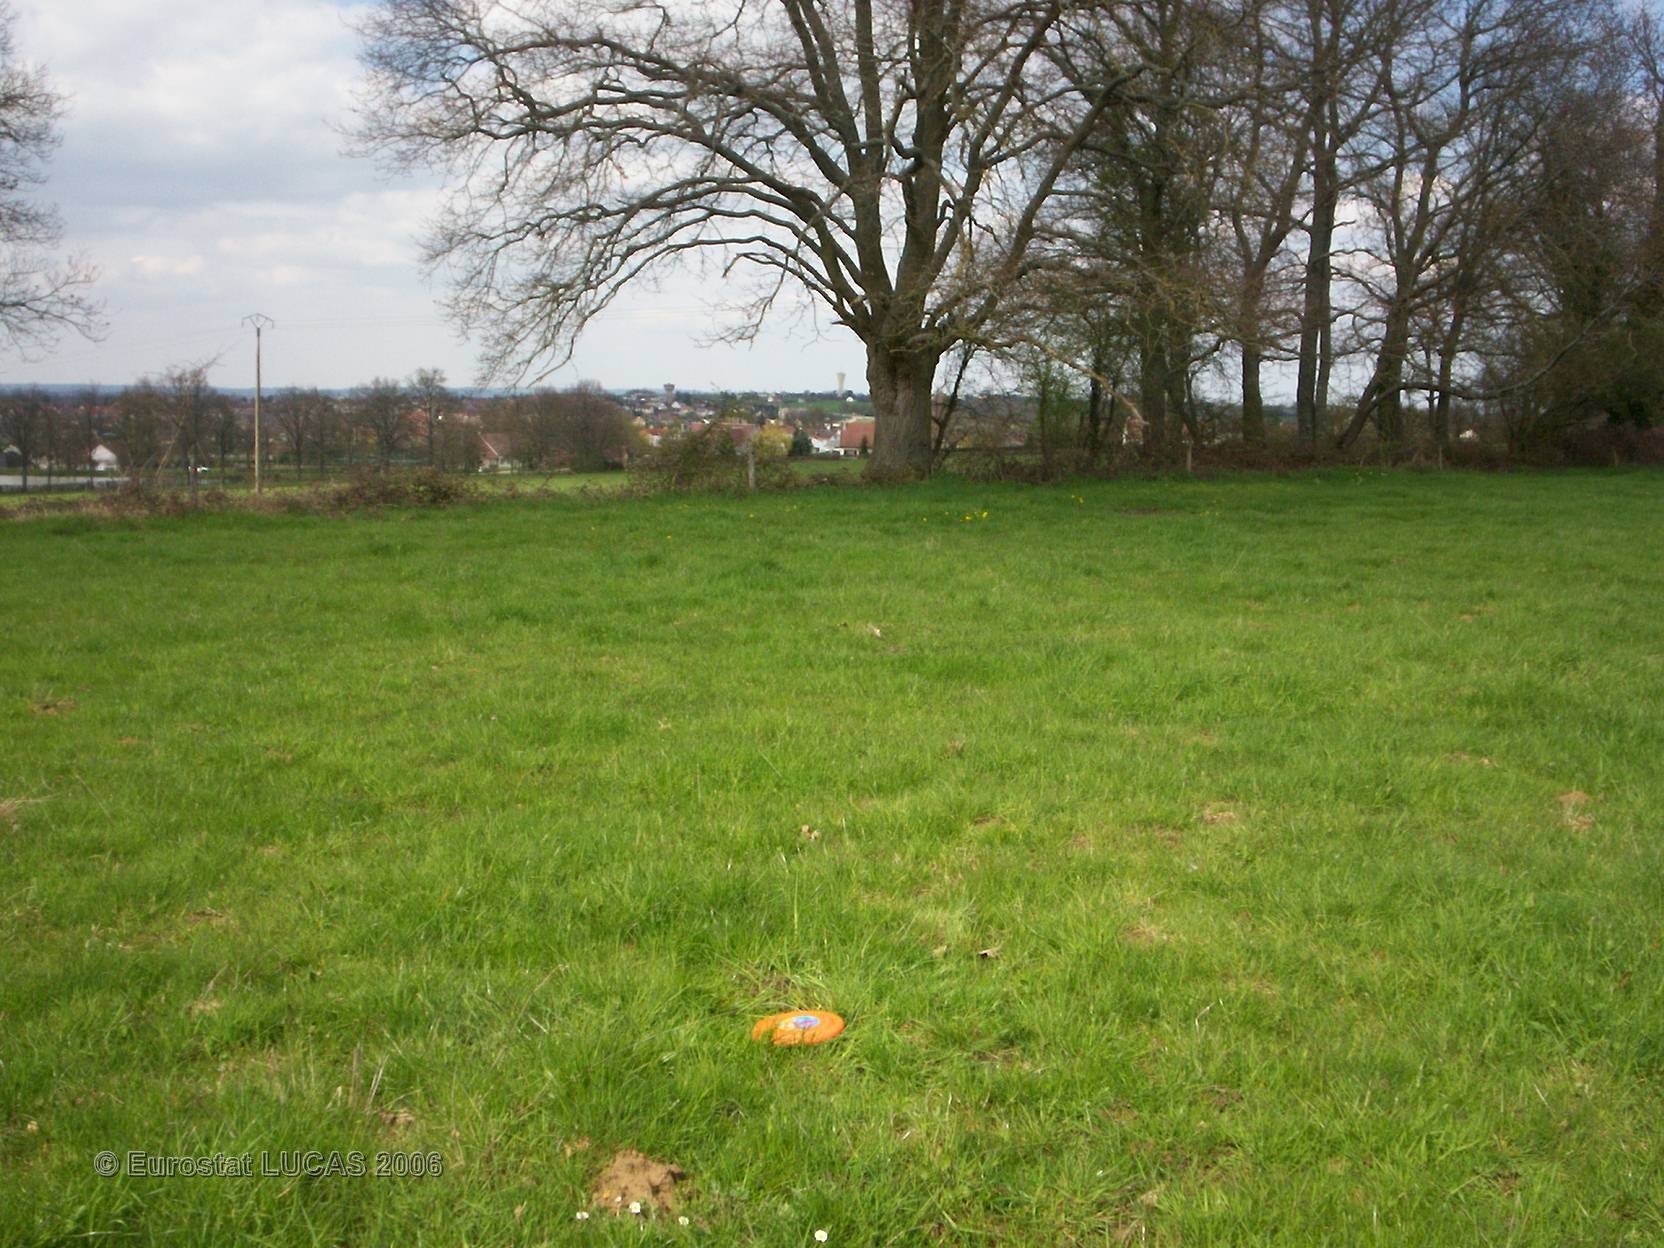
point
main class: Grassland
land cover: Grassland without tree/shrub cover
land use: Agriculture (excluding fallow land and kitchen gardens)
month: April
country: FR
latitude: 46.7802
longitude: 3.1205
